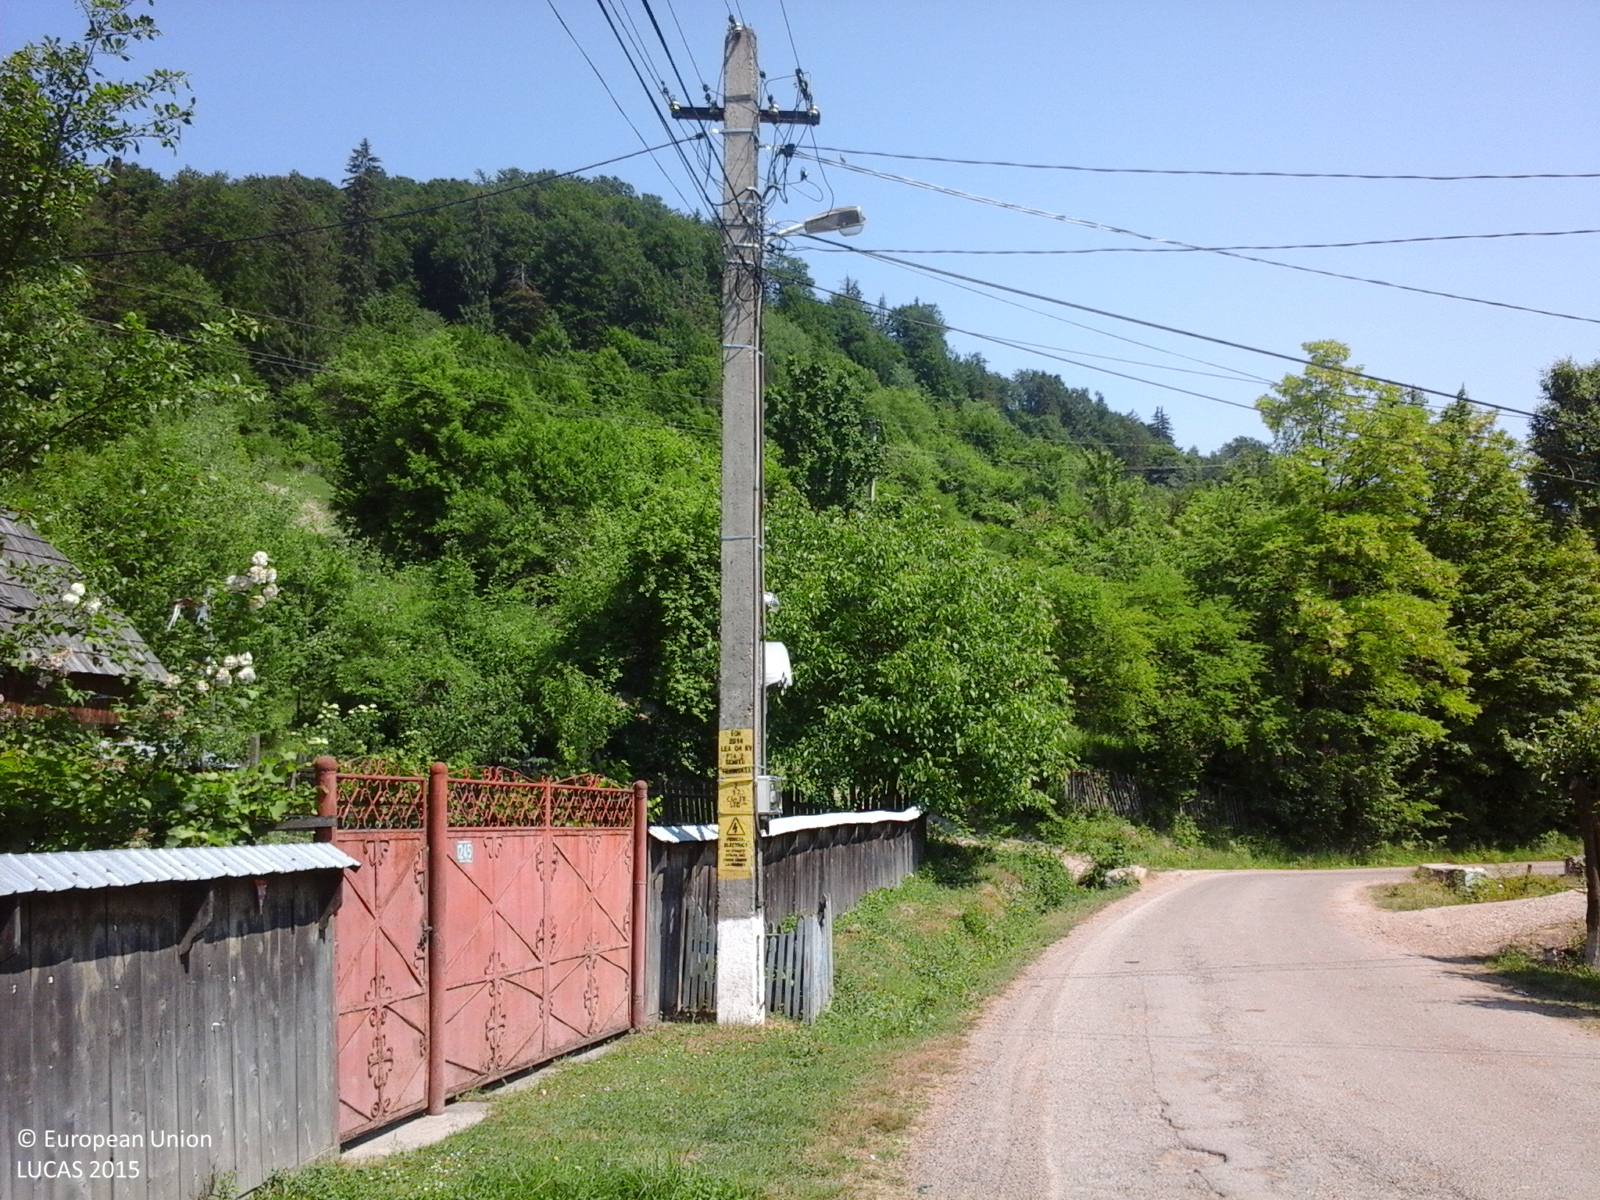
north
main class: Woodland
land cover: Other mixed woodland
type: beech forest
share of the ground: > 75 %
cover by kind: broadleaved forest trees 70 %, coniferous forest trees 30 %
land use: Forestry
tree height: > 5 m
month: June
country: RO
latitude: 46.6376
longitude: 26.5035
